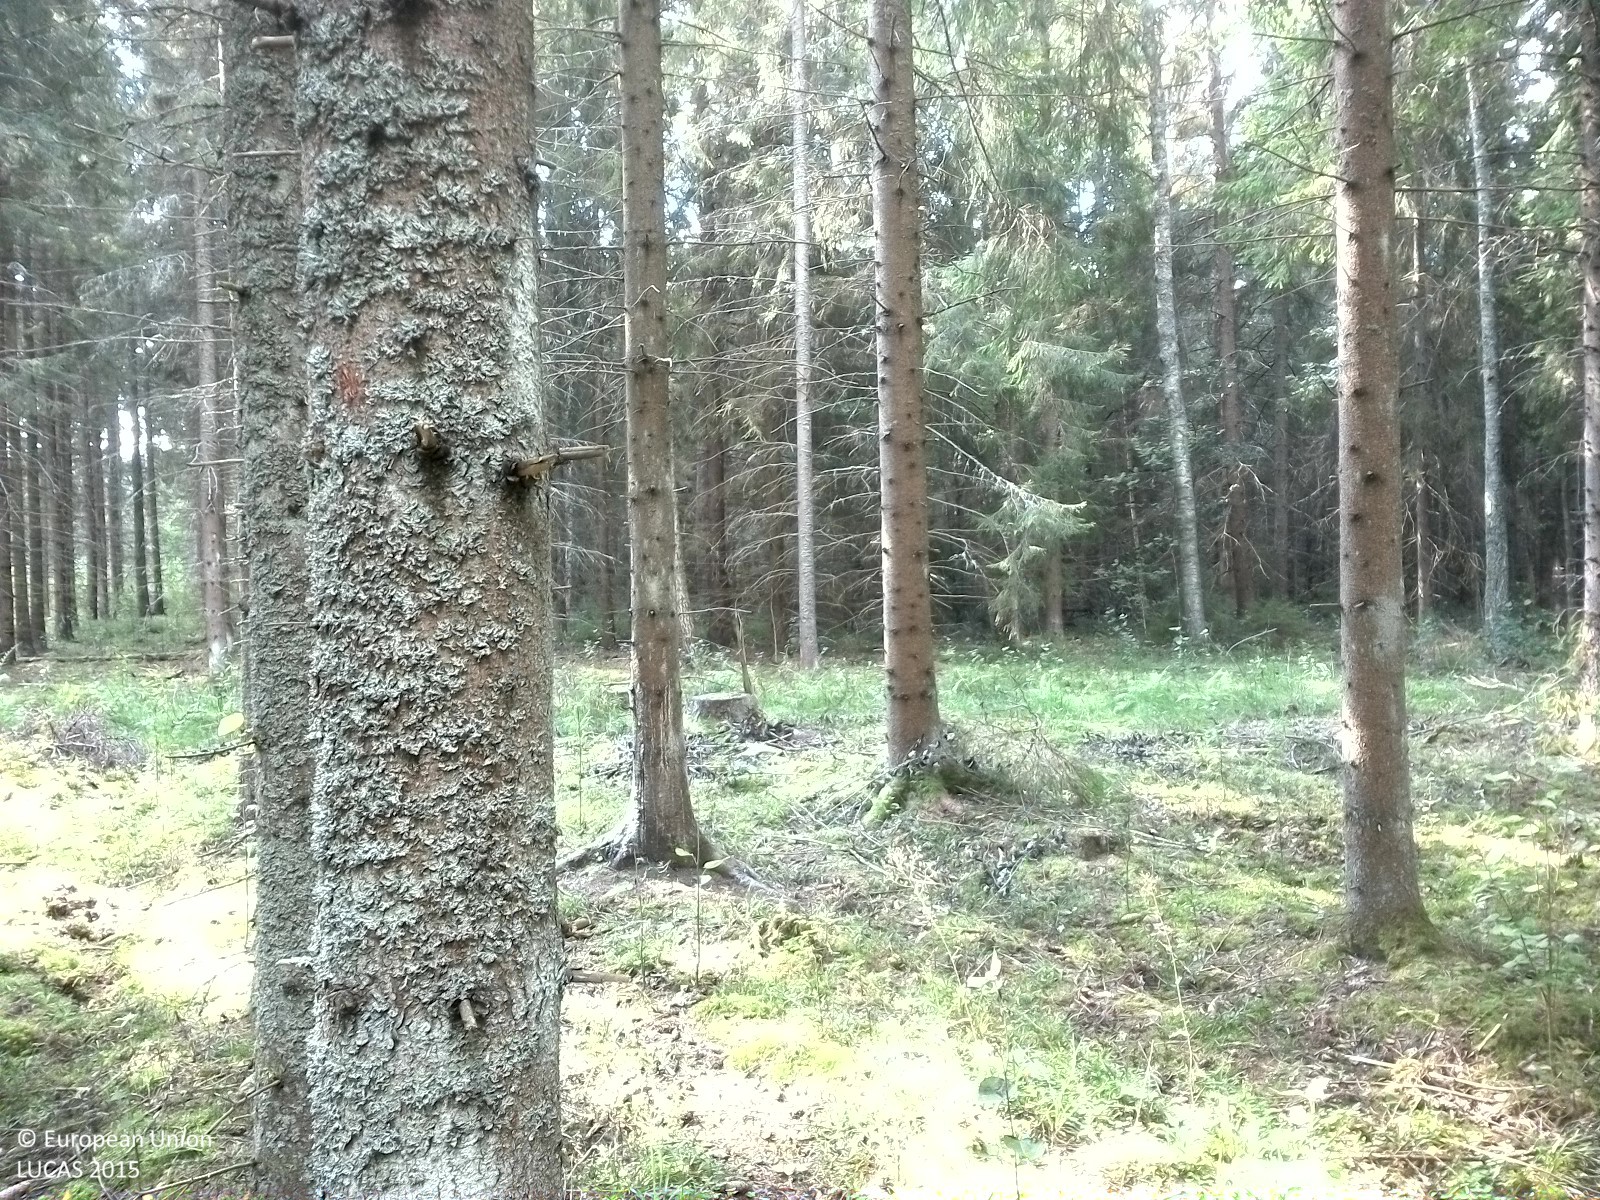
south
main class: Woodland
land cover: Spruce dominated coniferous woodland
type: boreal forest
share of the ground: 25 - 50 %
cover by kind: coniferous forest trees 40 %, lichens and mosses 30 %, herbaceous plants 25 %, broadleaved forest trees 5 %
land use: Forestry
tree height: > 5 m
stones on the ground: < 10 %
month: August
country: SE
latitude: 59.1475
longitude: 15.6392
